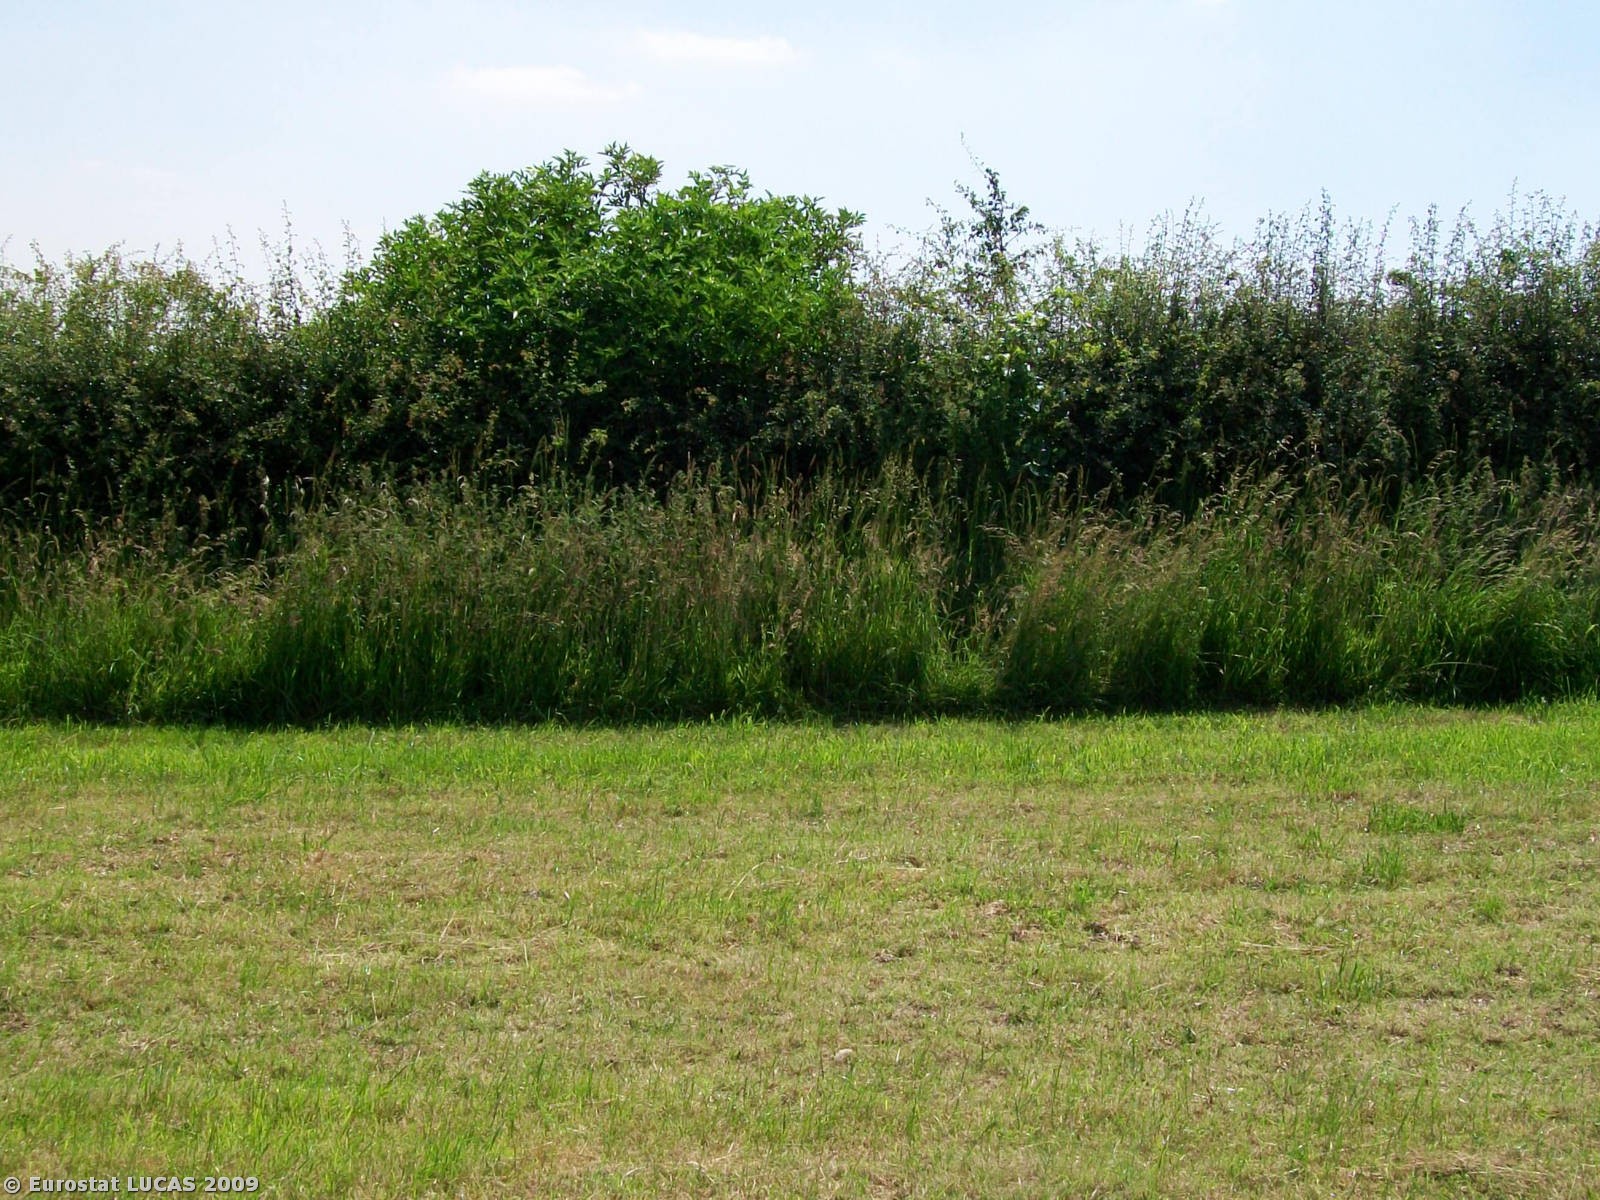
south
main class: Grassland
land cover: Grassland without tree/shrub cover
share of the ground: < 10 %
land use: Agriculture (excluding fallow land and kitchen gardens)
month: July
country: GB
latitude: 53.9281
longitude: -1.4557
